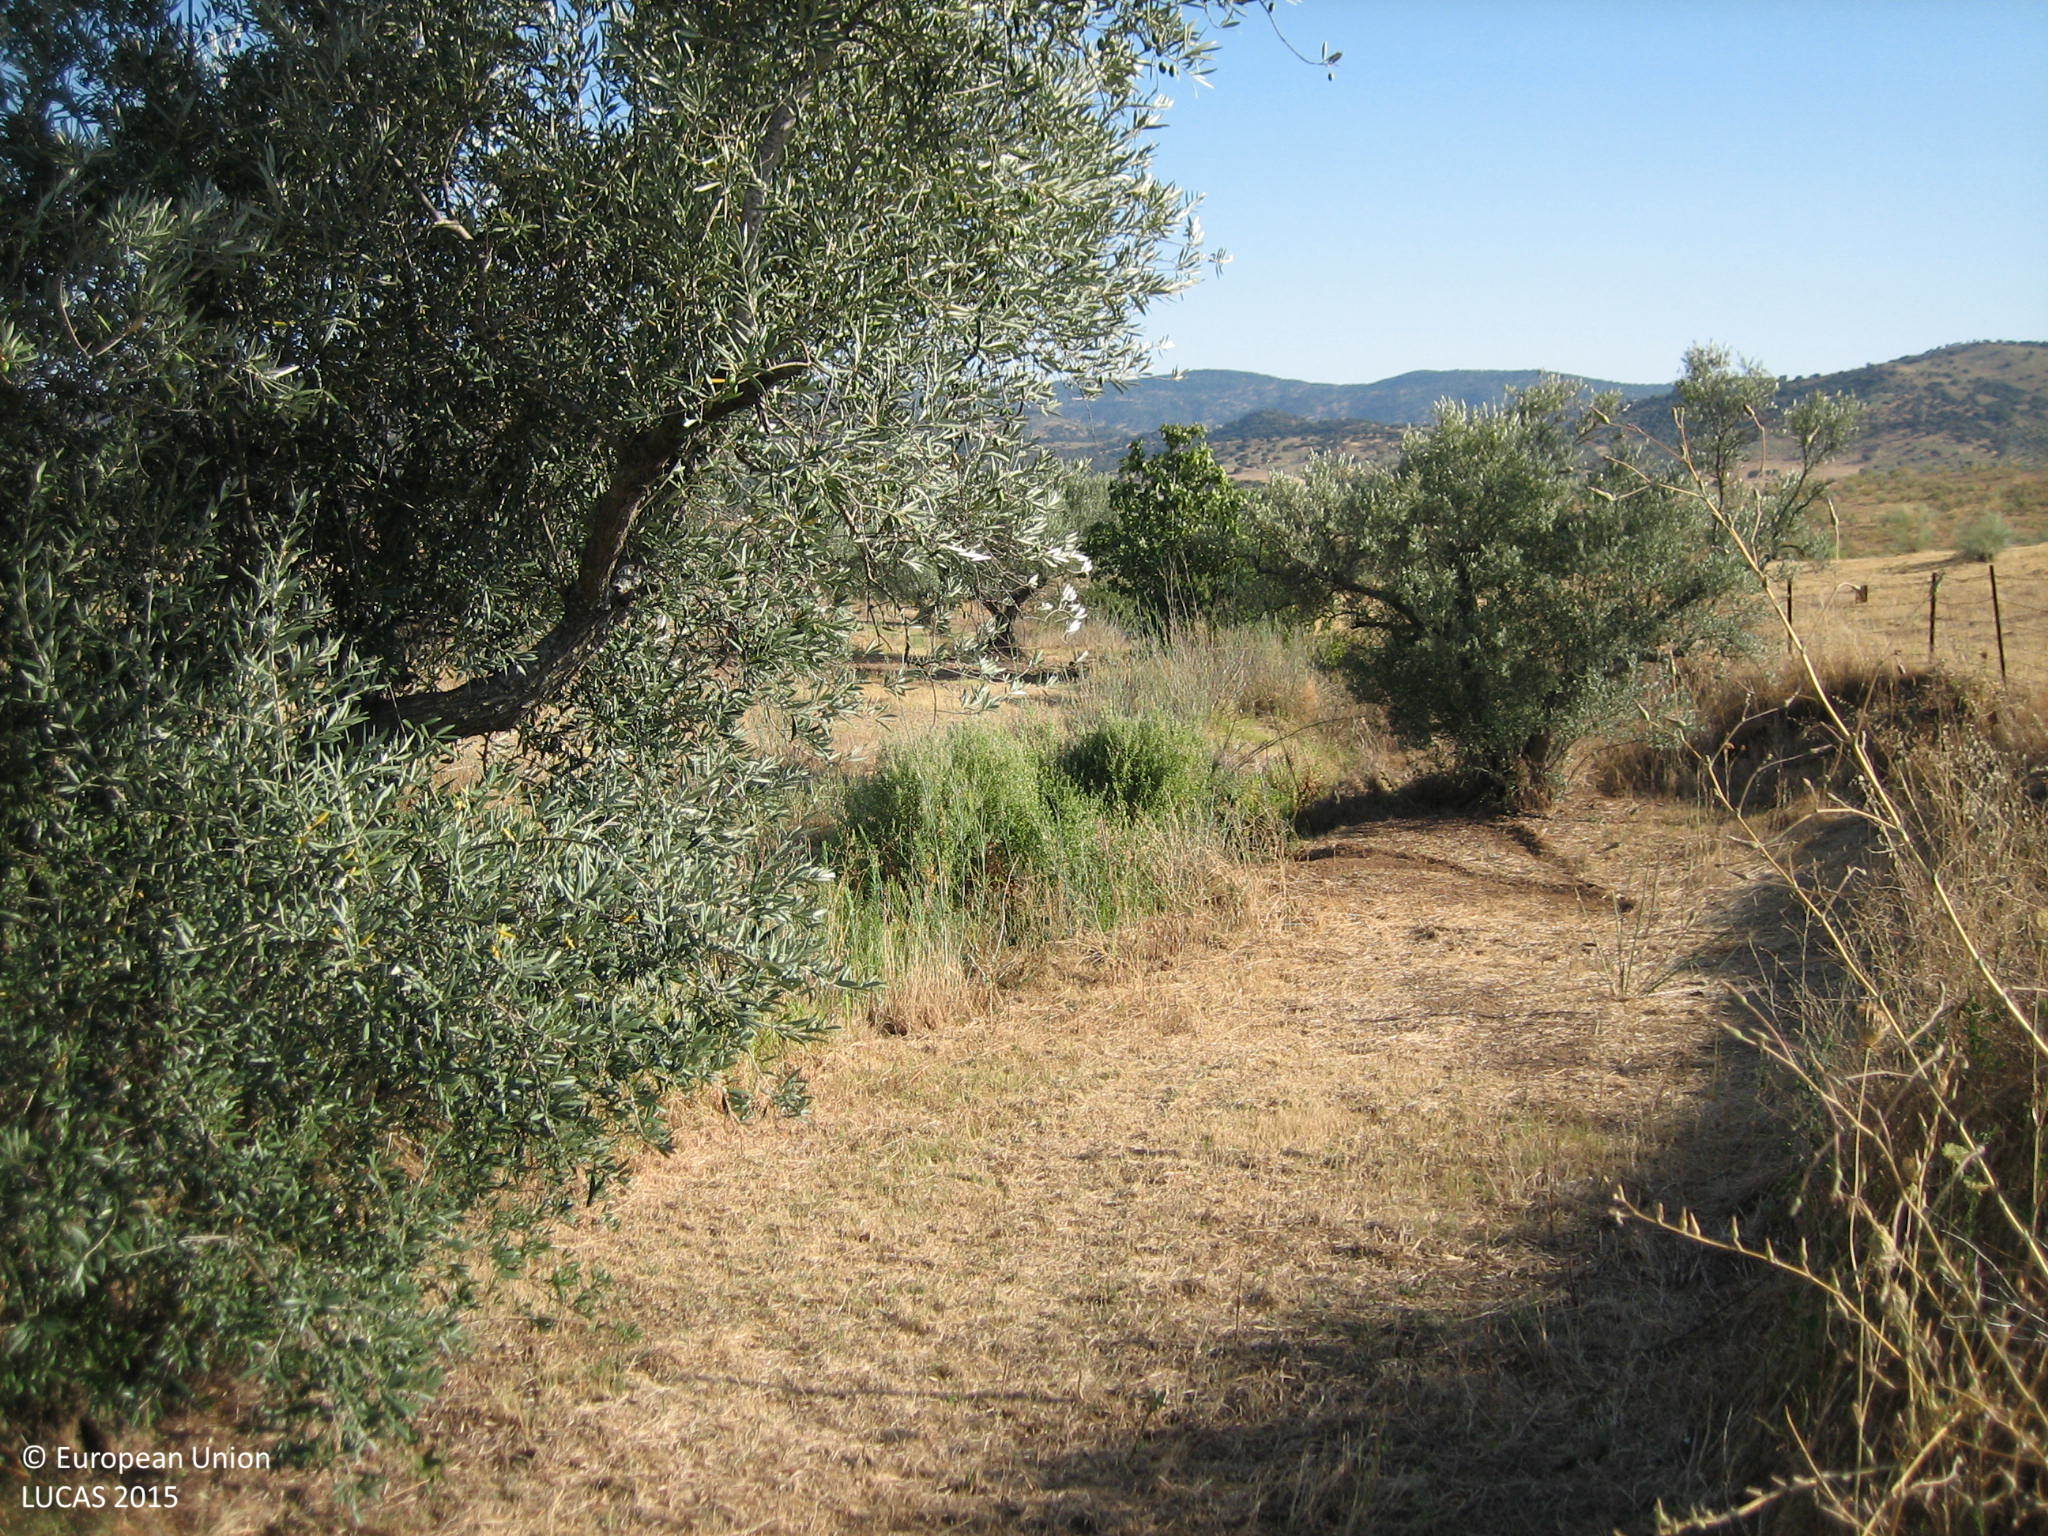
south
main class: Grassland
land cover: Grassland without tree/shrub cover
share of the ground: > 75 %
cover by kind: herbaceous plants 80 %, unconsolidated bare surface 20 %
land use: Agriculture (excluding fallow land and kitchen gardens)
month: July
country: ES
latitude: 38.0525
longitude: -6.0485
